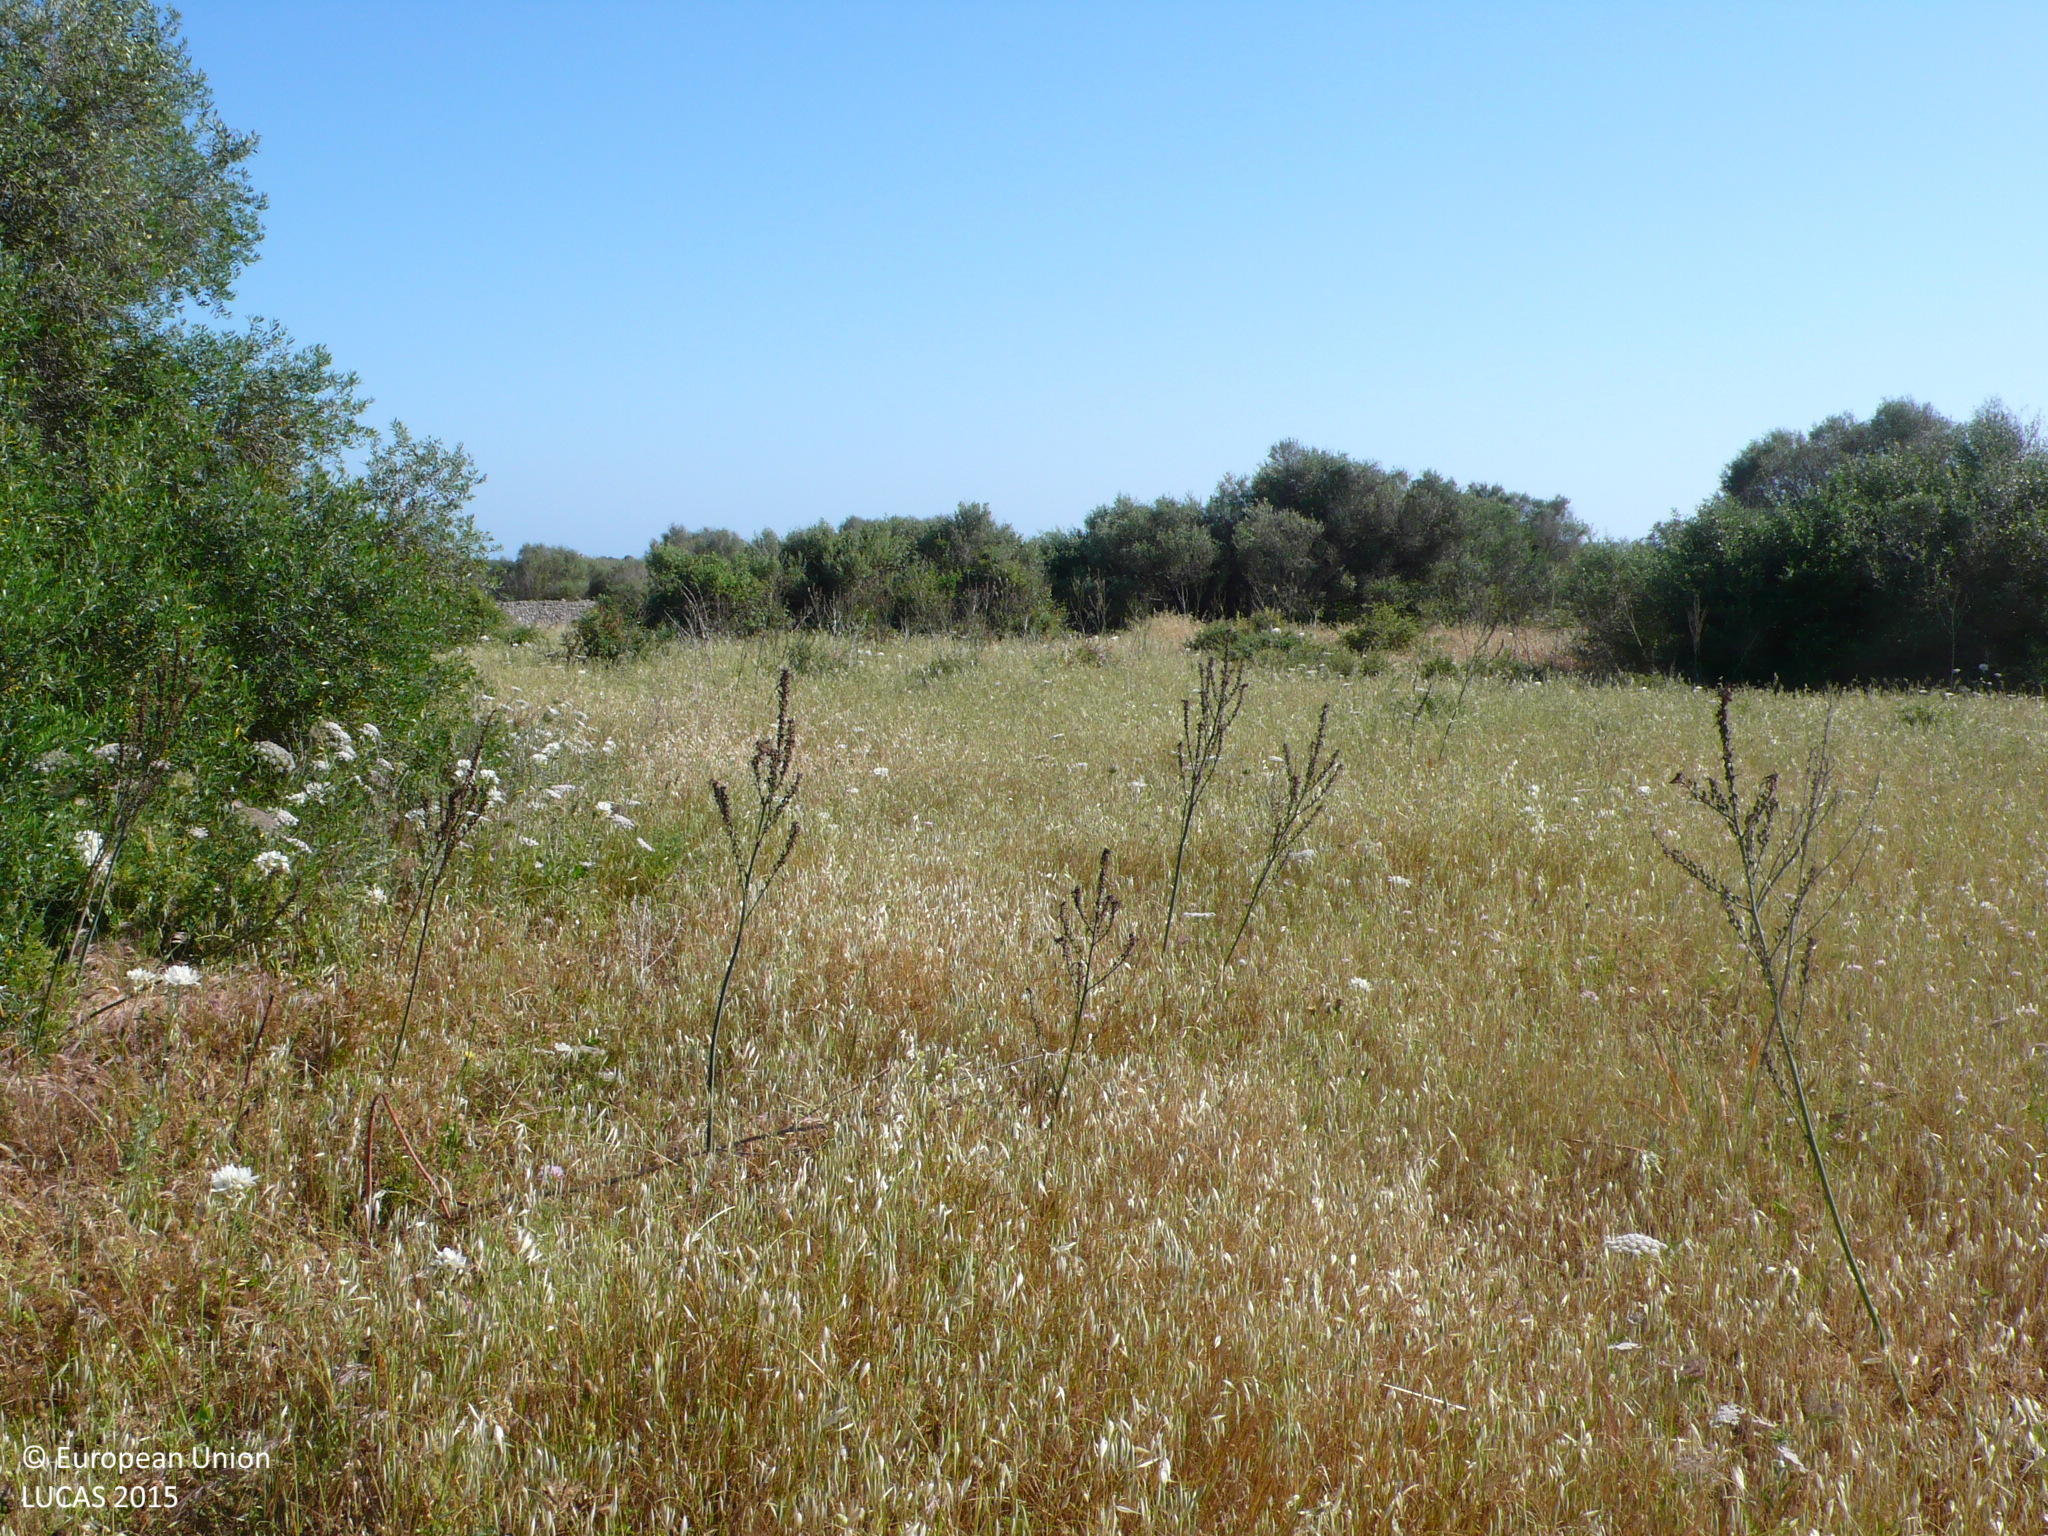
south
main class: Woodland
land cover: Broadleaved woodland
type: broadleaved evergreen forest
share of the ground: 25 - 50 %
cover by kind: herbaceous plants 50 %, broadleaved forest trees 30 %, shrubs 20 %
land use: Semi-natural and natural areas not in use
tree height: < 5 m
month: May
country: ES
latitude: 39.8774
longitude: 4.1918
